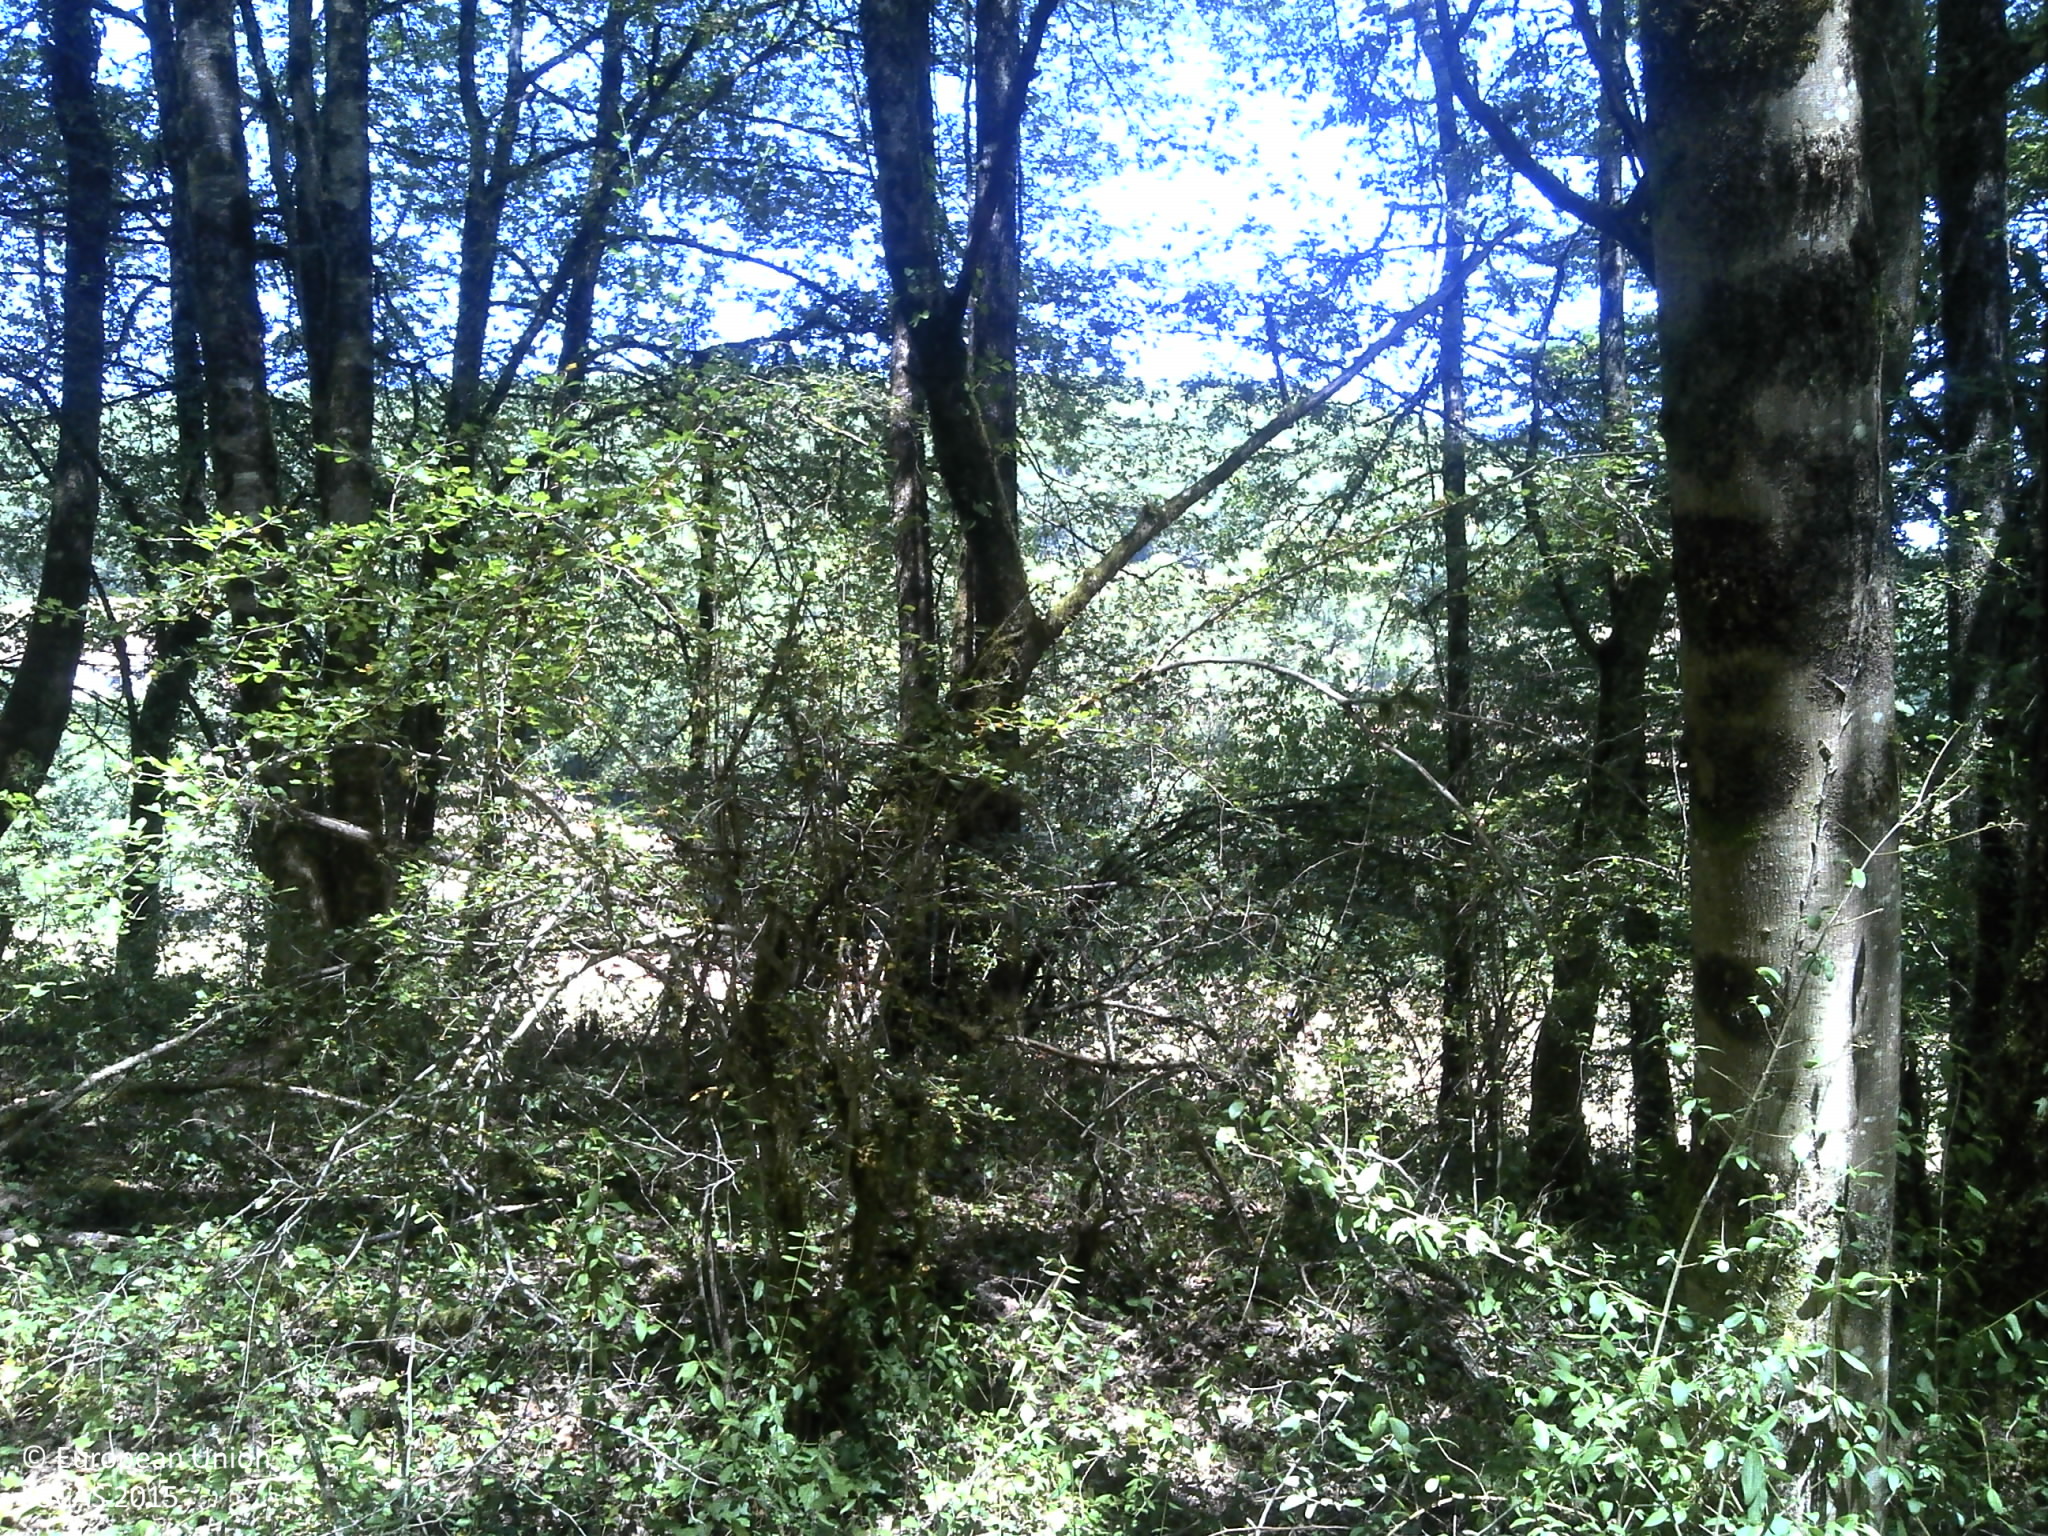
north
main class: Woodland
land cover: Broadleaved woodland
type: thermophilous deciduous forest
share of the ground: > 75 %
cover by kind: broadleaved forest trees 65 %, herbaceous plants 20 %, unconsolidated bare surface 5 %
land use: Abandoned areas
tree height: > 5 m
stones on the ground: < 10 %
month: July
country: FR
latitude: 45.0528
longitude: 1.7307
